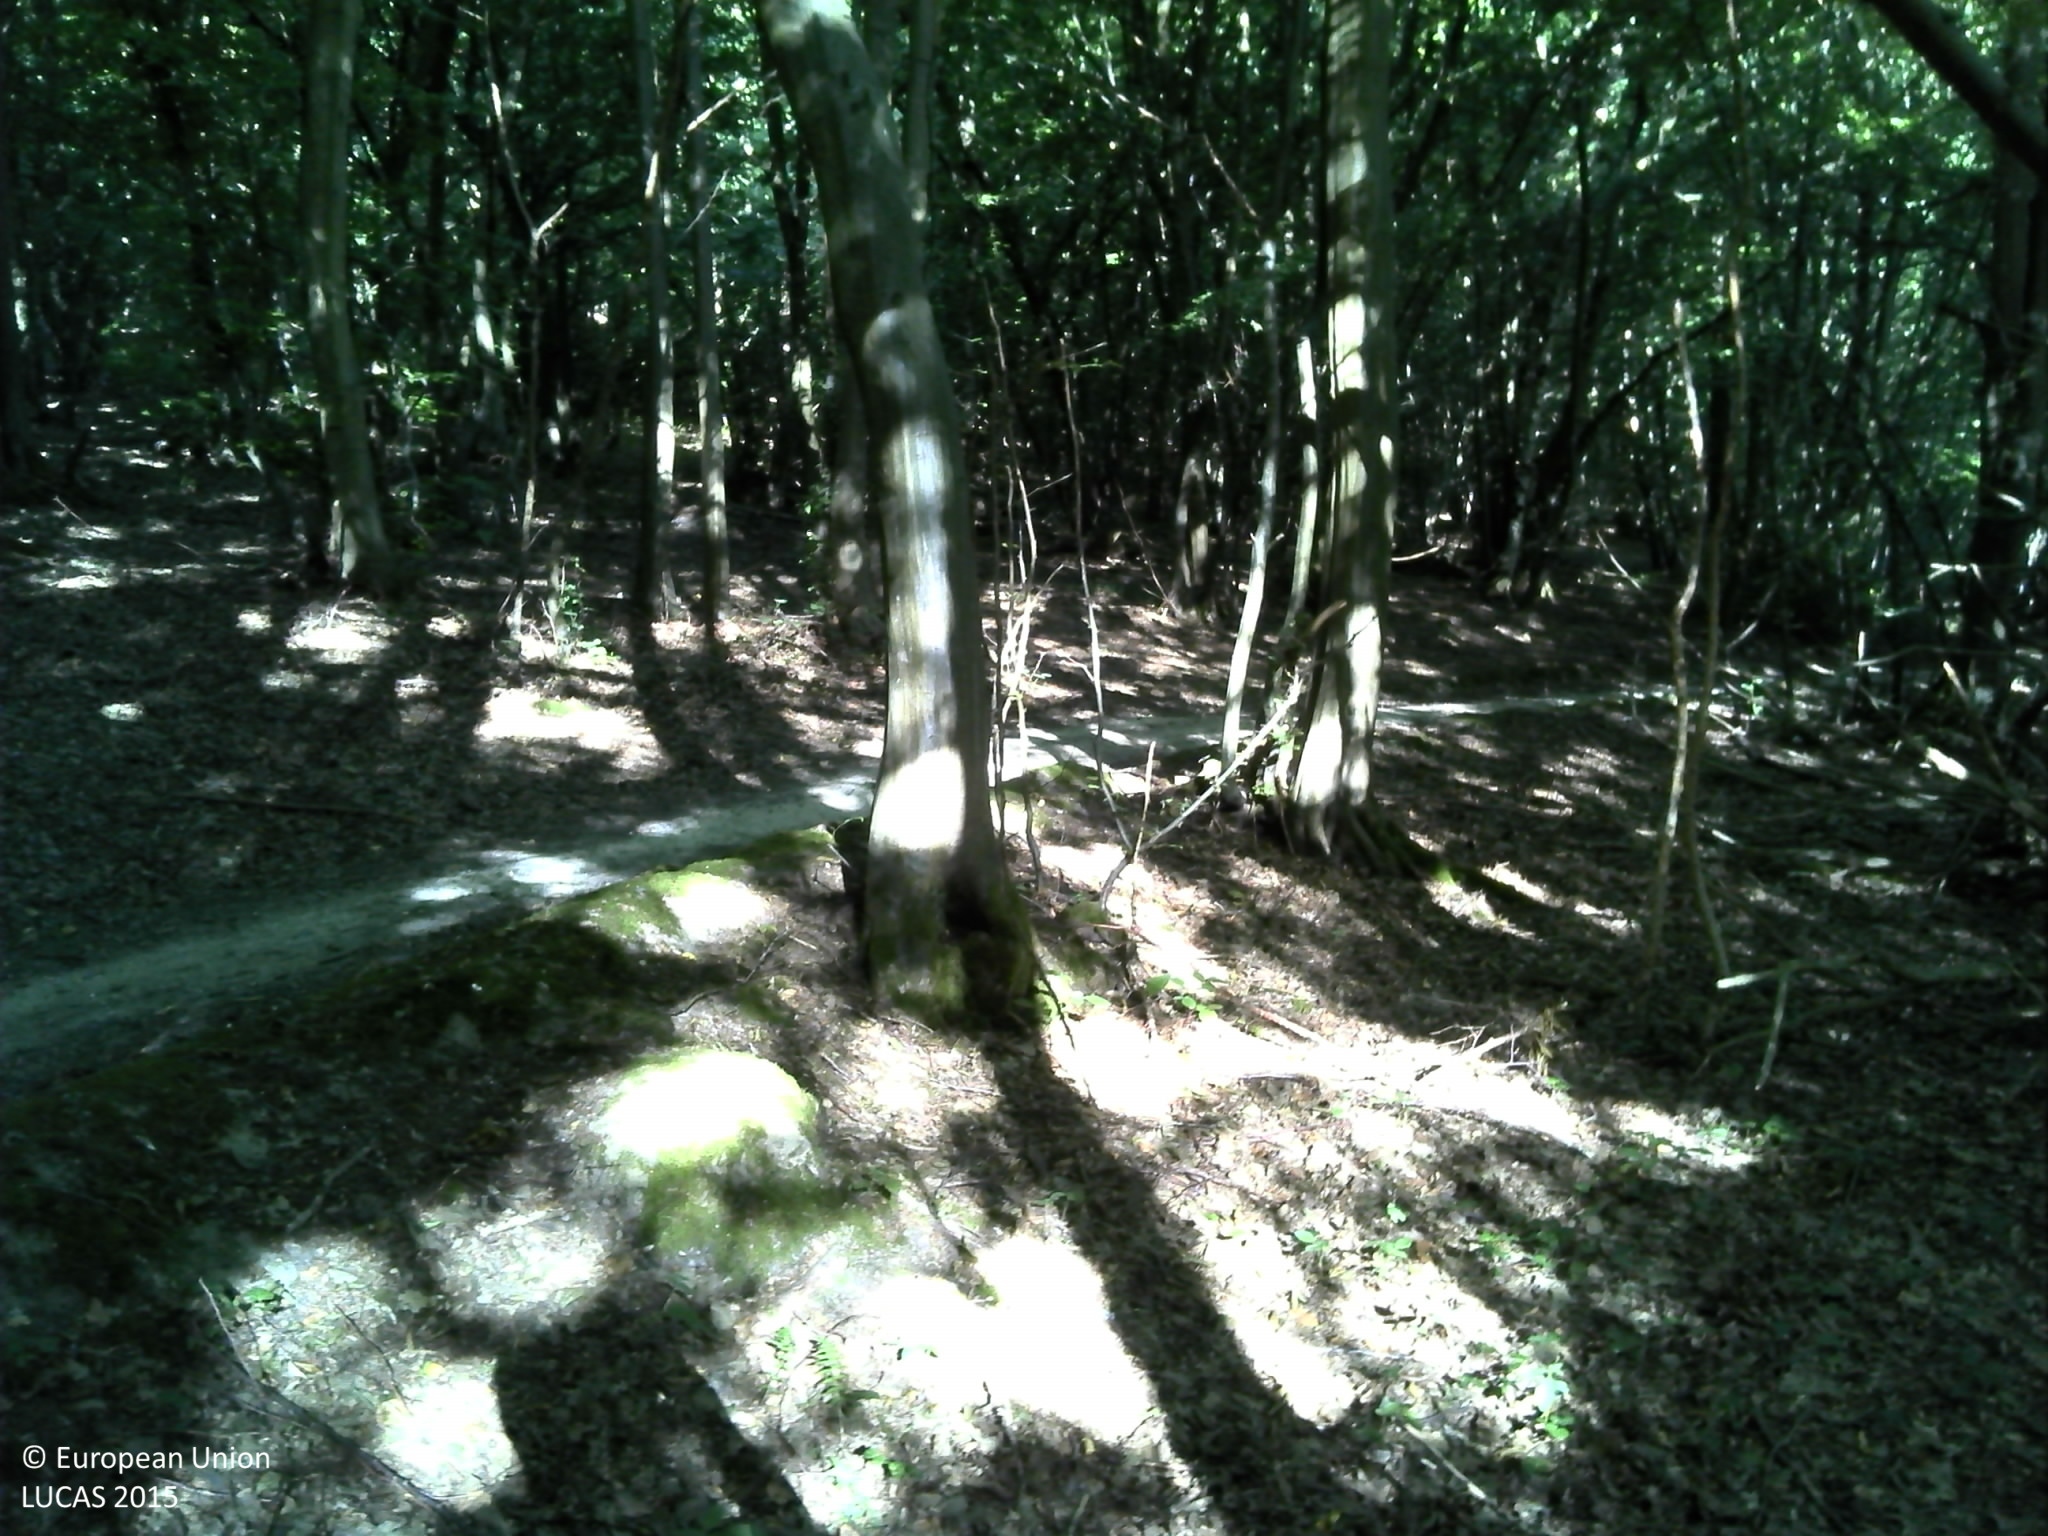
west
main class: Woodland
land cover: Broadleaved woodland
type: mesophytic deciduous forest
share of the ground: > 75 %
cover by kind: broadleaved forest trees 100 %
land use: Forestry
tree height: > 5 m
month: June
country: FR
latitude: 49.2692
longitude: 1.0314
